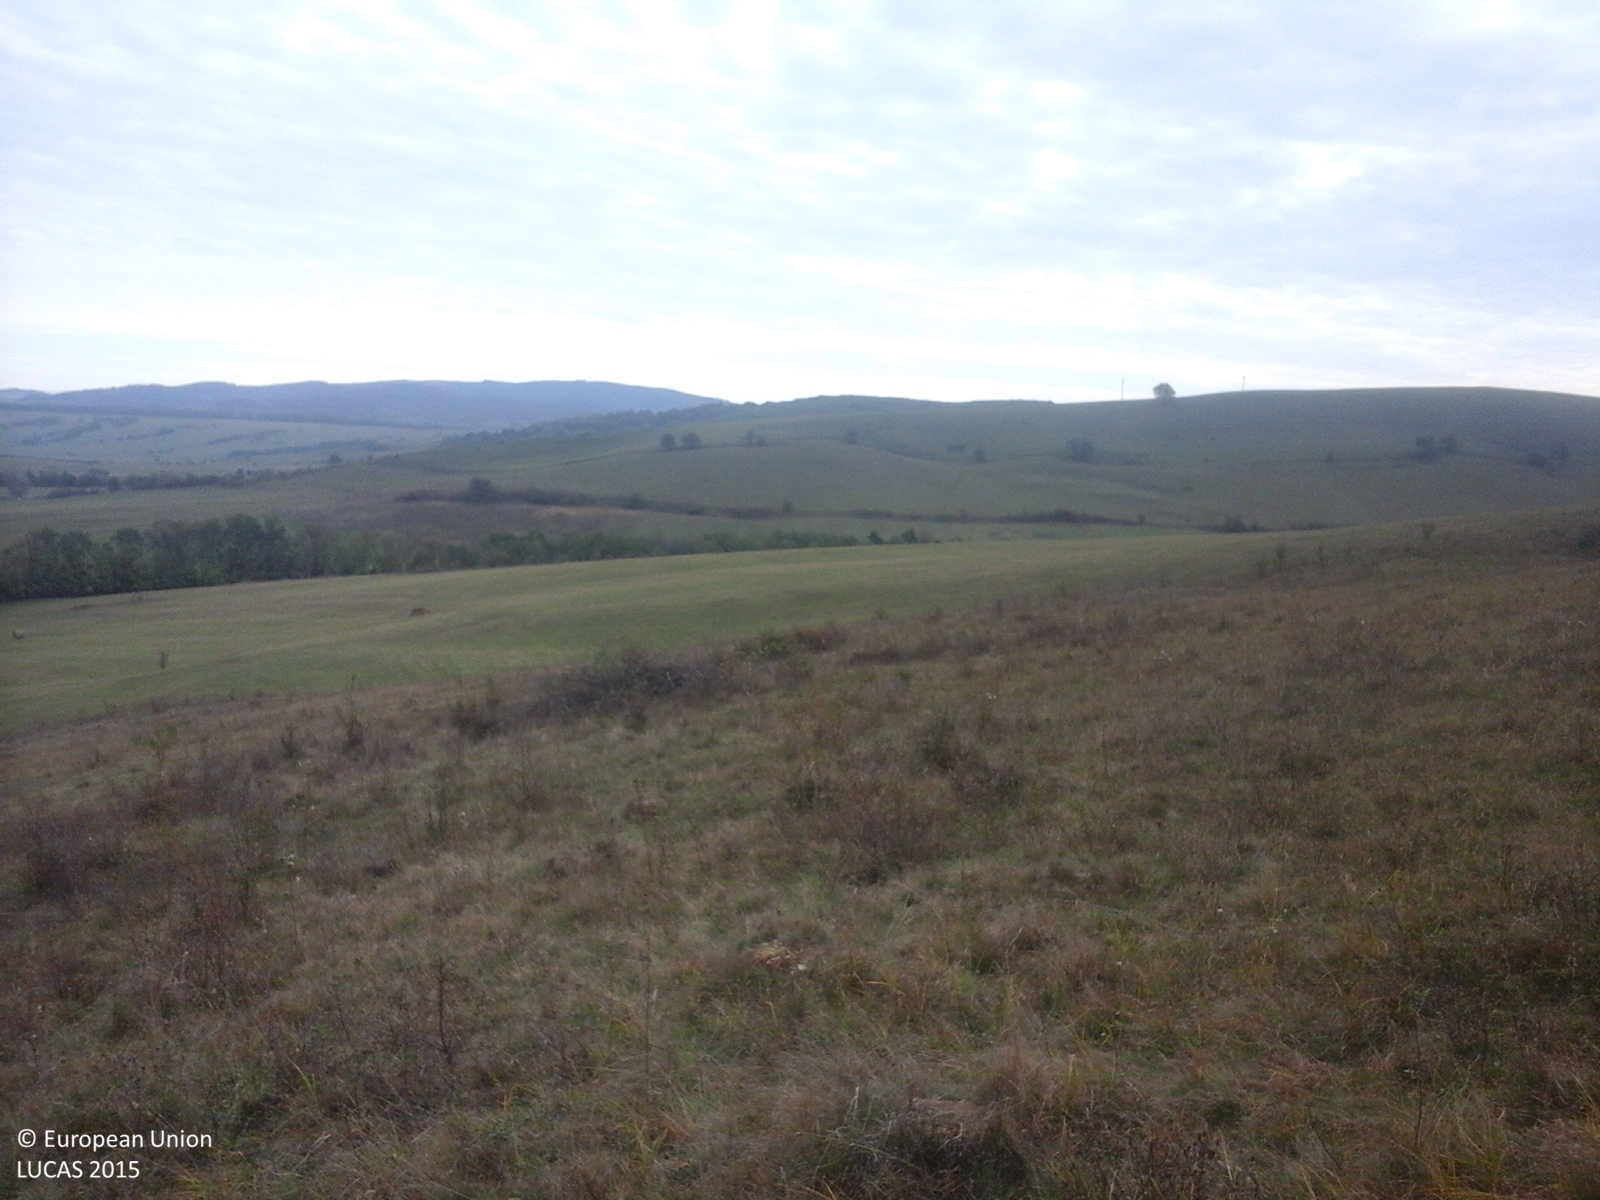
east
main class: Grassland
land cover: Grassland without tree/shrub cover
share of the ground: > 75 %
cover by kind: herbaceous plants 100 %
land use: Agriculture (excluding fallow land and kitchen gardens)
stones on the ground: < 10 %
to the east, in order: Grassland without tree/shrub cover; Tracks; Grassland without tree/shrub cover
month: October
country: RO
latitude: 46.1660
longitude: 25.3728
